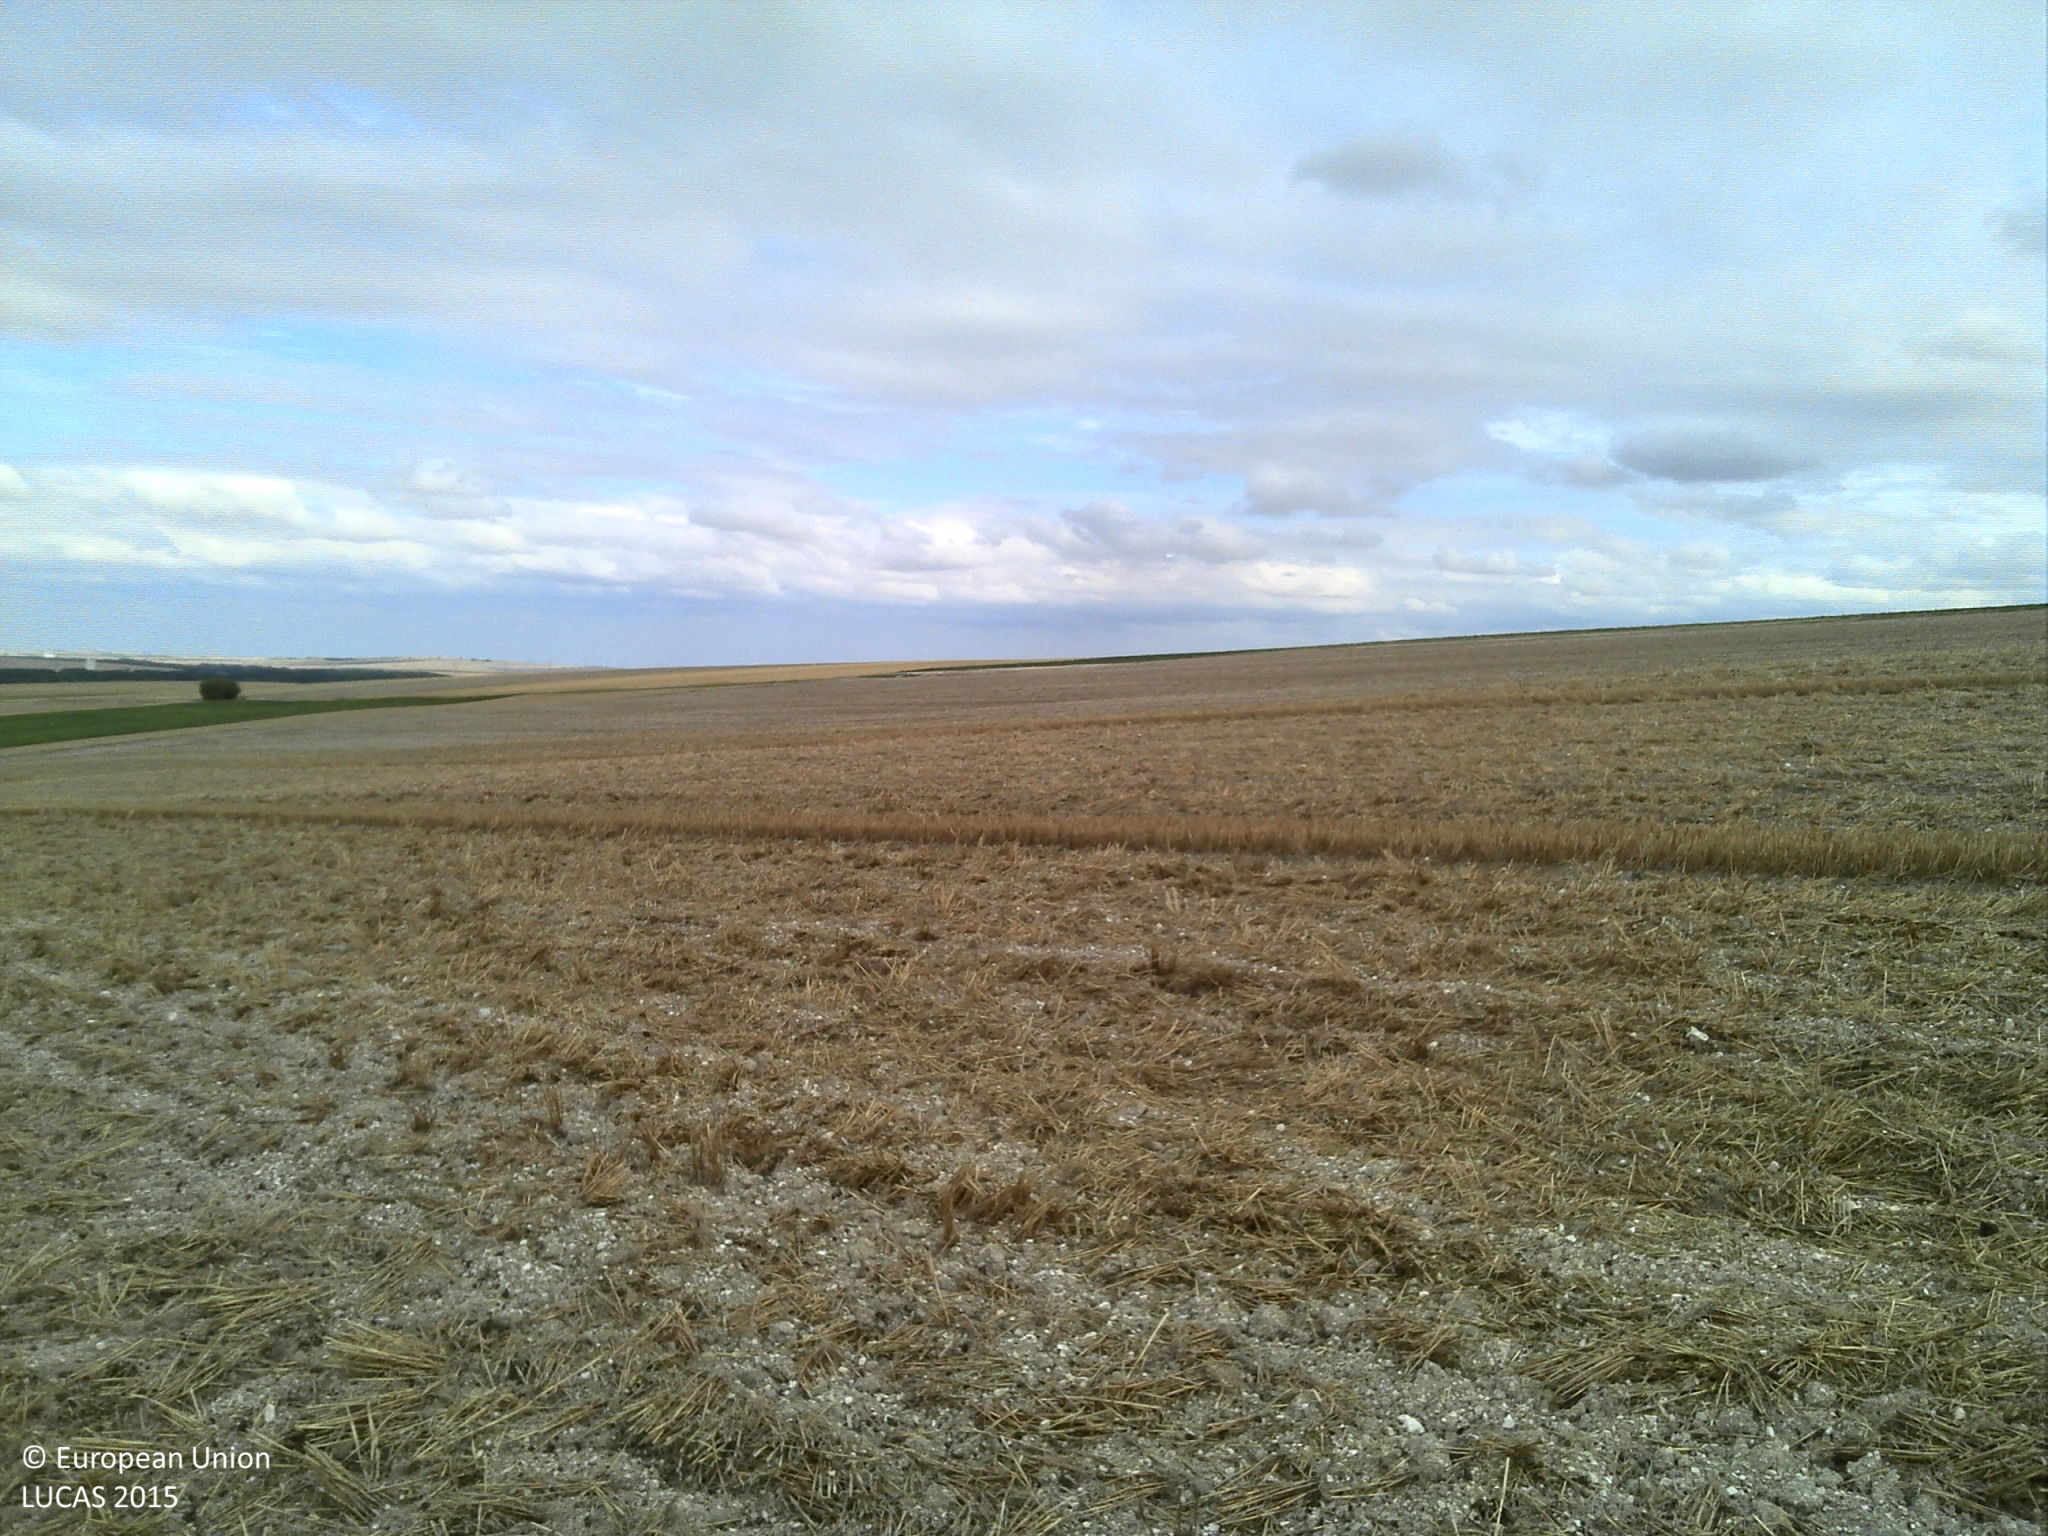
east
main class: Cropland
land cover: Common wheat
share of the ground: 25 - 50 %
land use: Agriculture (excluding fallow land and kitchen gardens)
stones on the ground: 10 - 25 %
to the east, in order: Common wheat; Rape and turnip rape; Grass margins; Tracks; Grass margins; Sugar beet
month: August
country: FR
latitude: 48.4882
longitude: 4.2461
